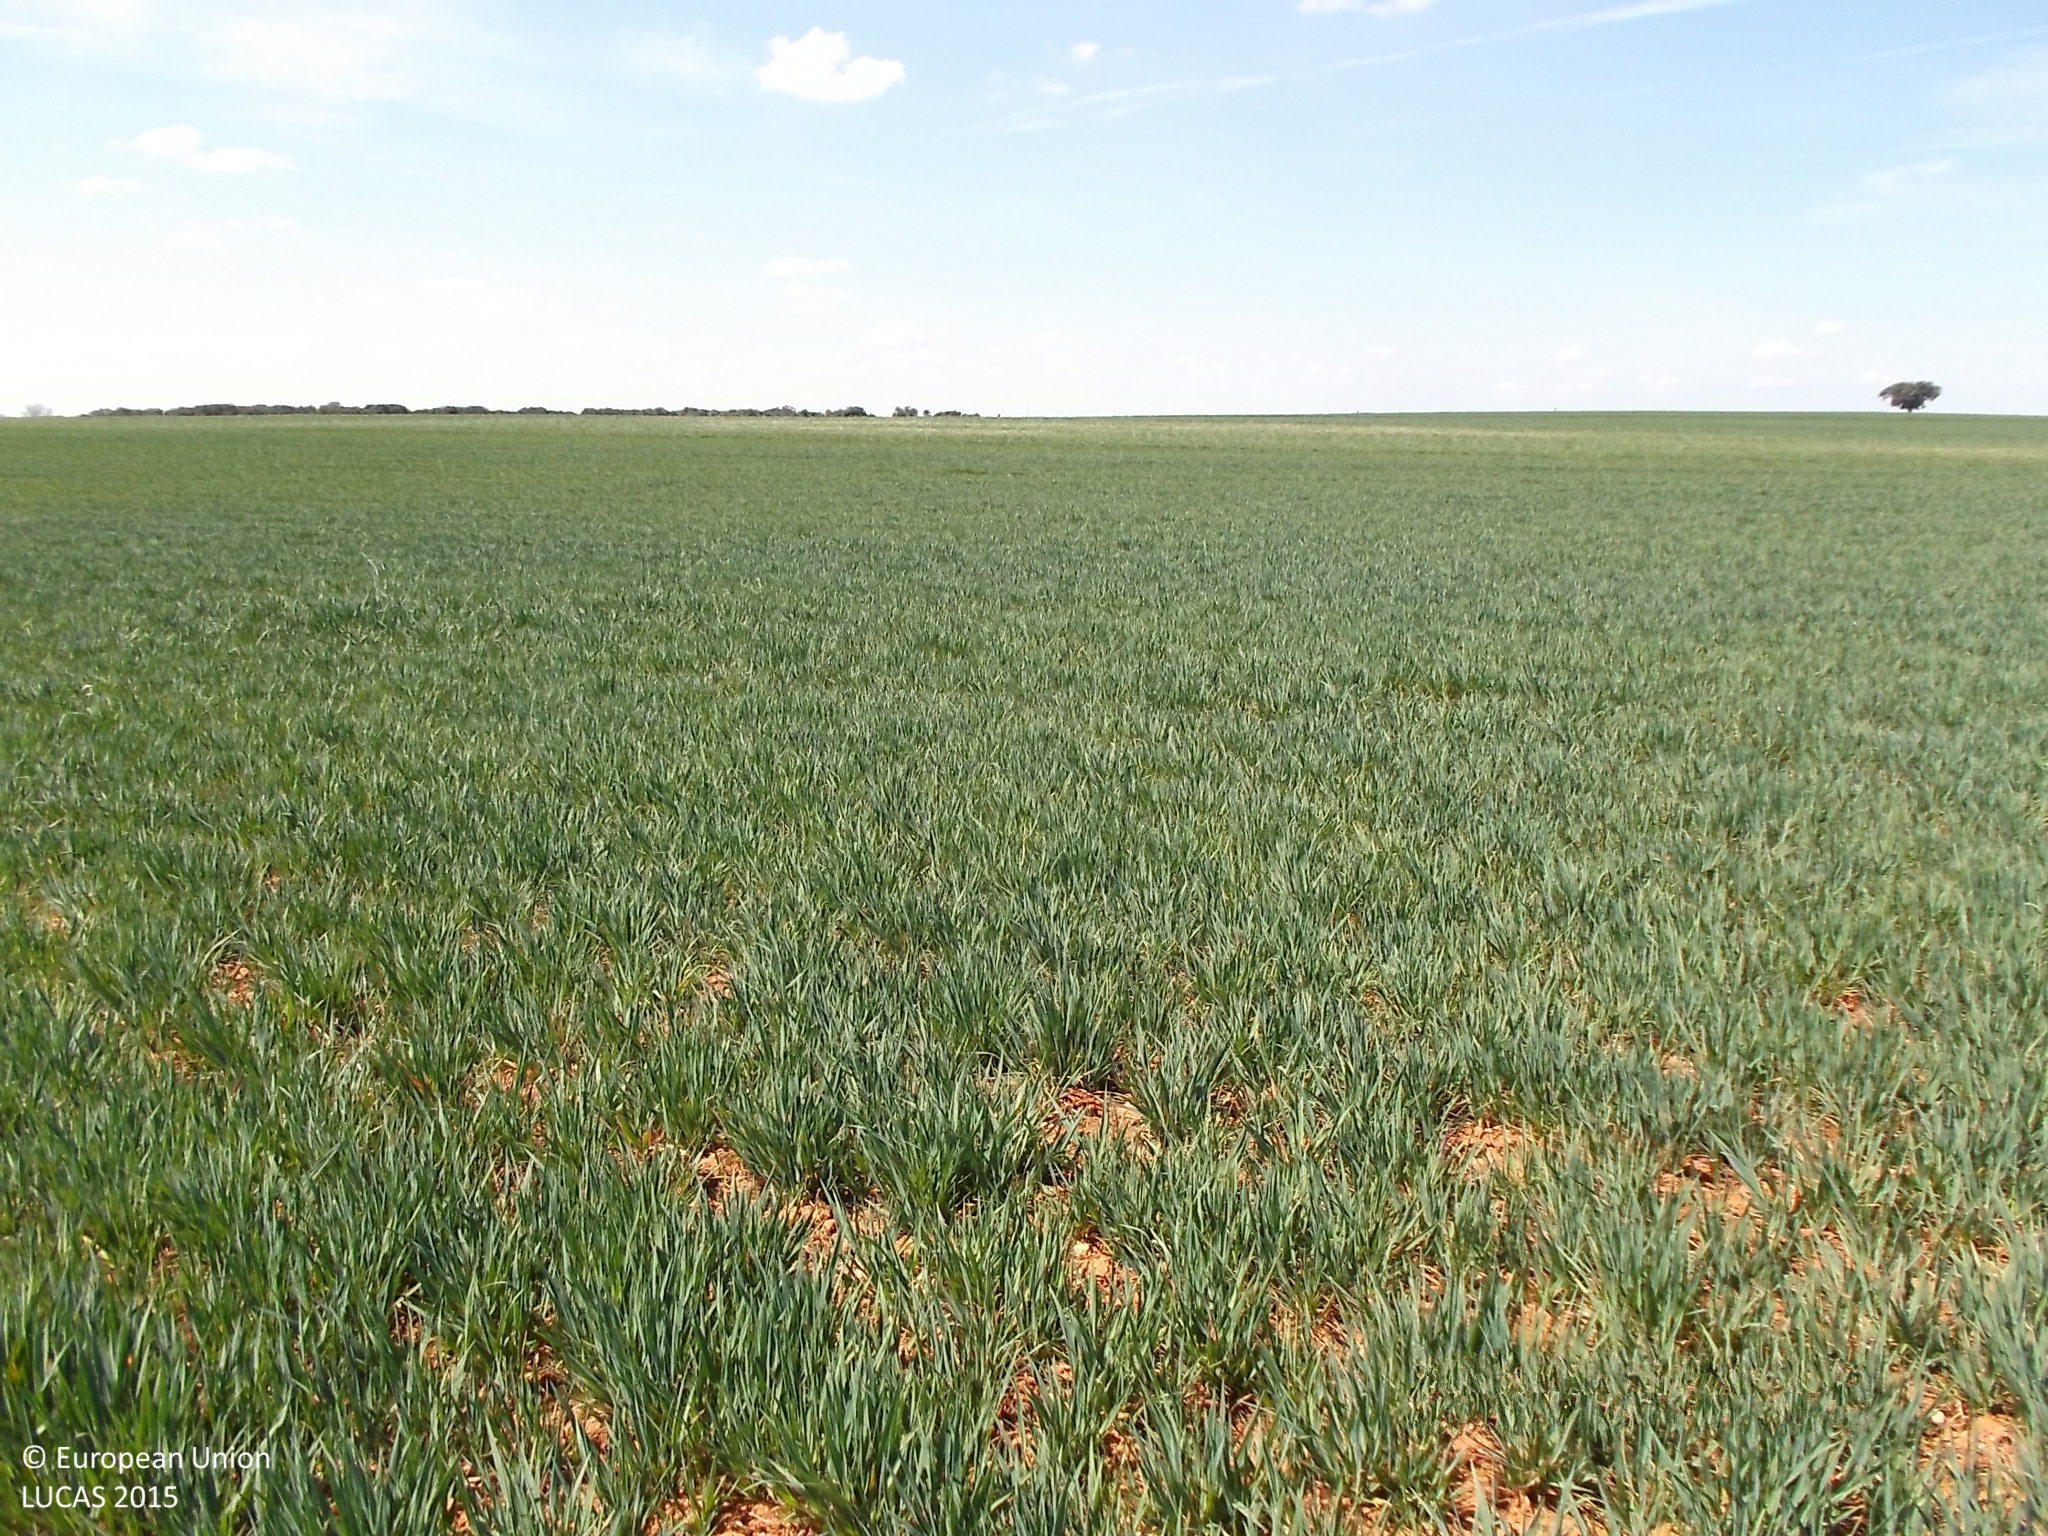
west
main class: Cropland
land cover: Oats
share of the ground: > 75 %
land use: Agriculture (excluding fallow land and kitchen gardens)
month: April
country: ES
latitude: 40.8669
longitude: -5.9444
